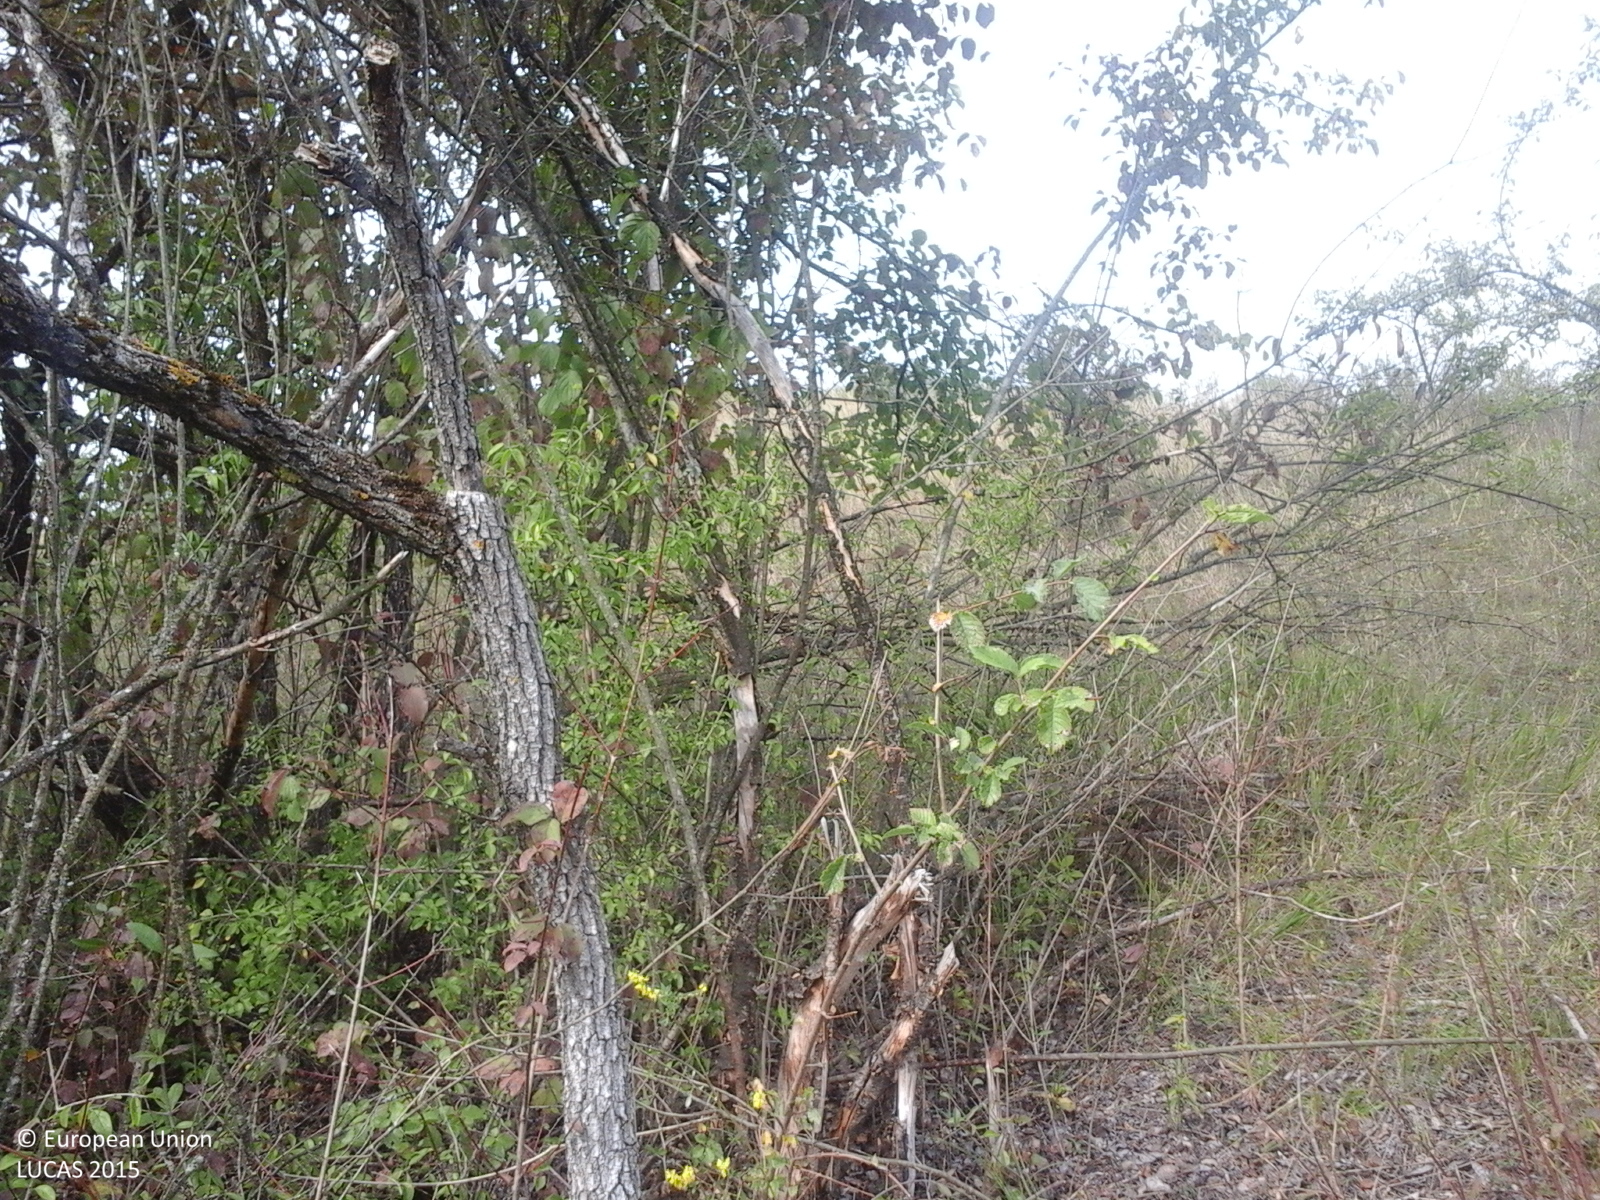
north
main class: Shrubland
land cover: Shrubland with sparse tree cover
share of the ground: > 75 %
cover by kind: herbaceous plants 85 %, shrubs 10 %, broadleaved forest trees 5 %
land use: Fallow land
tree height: < 5 m
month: September
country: RO
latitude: 46.9536
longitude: 23.6198
